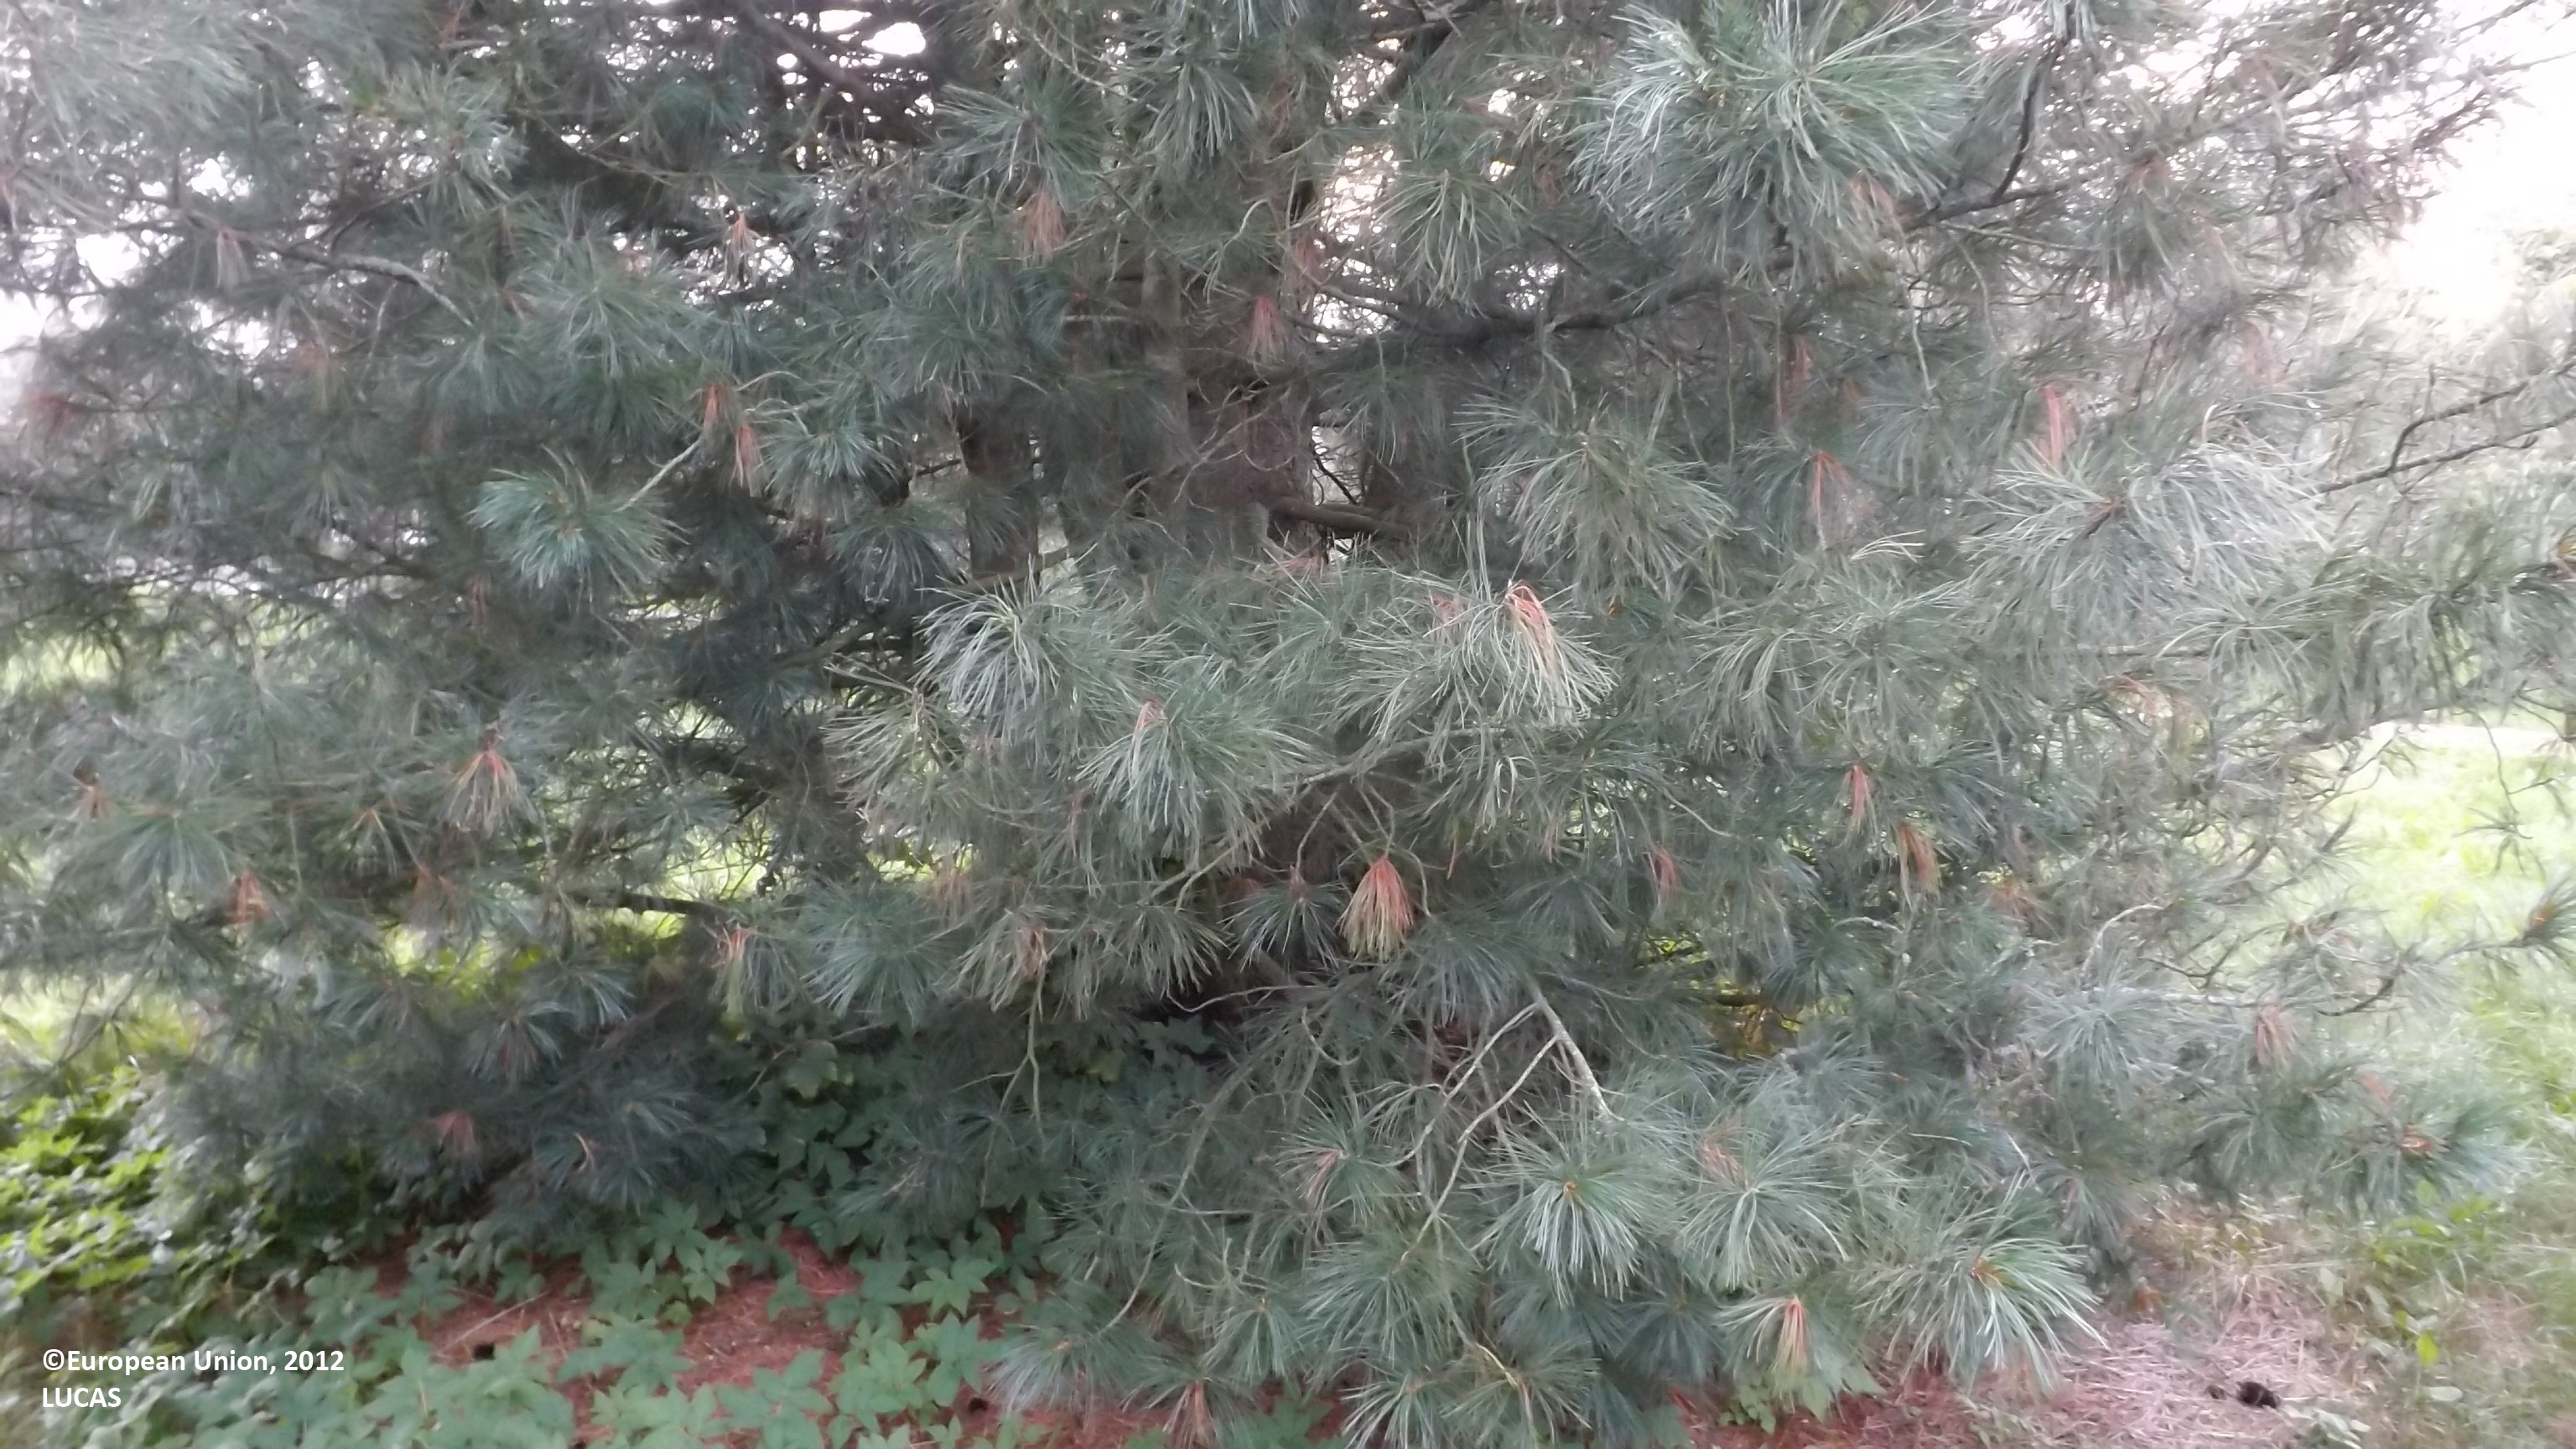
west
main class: Grassland
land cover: Grassland with sparse tree/shrub cover
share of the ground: 25 - 50 %
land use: Residential
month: August
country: FI
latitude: 63.8579
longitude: 23.4637
